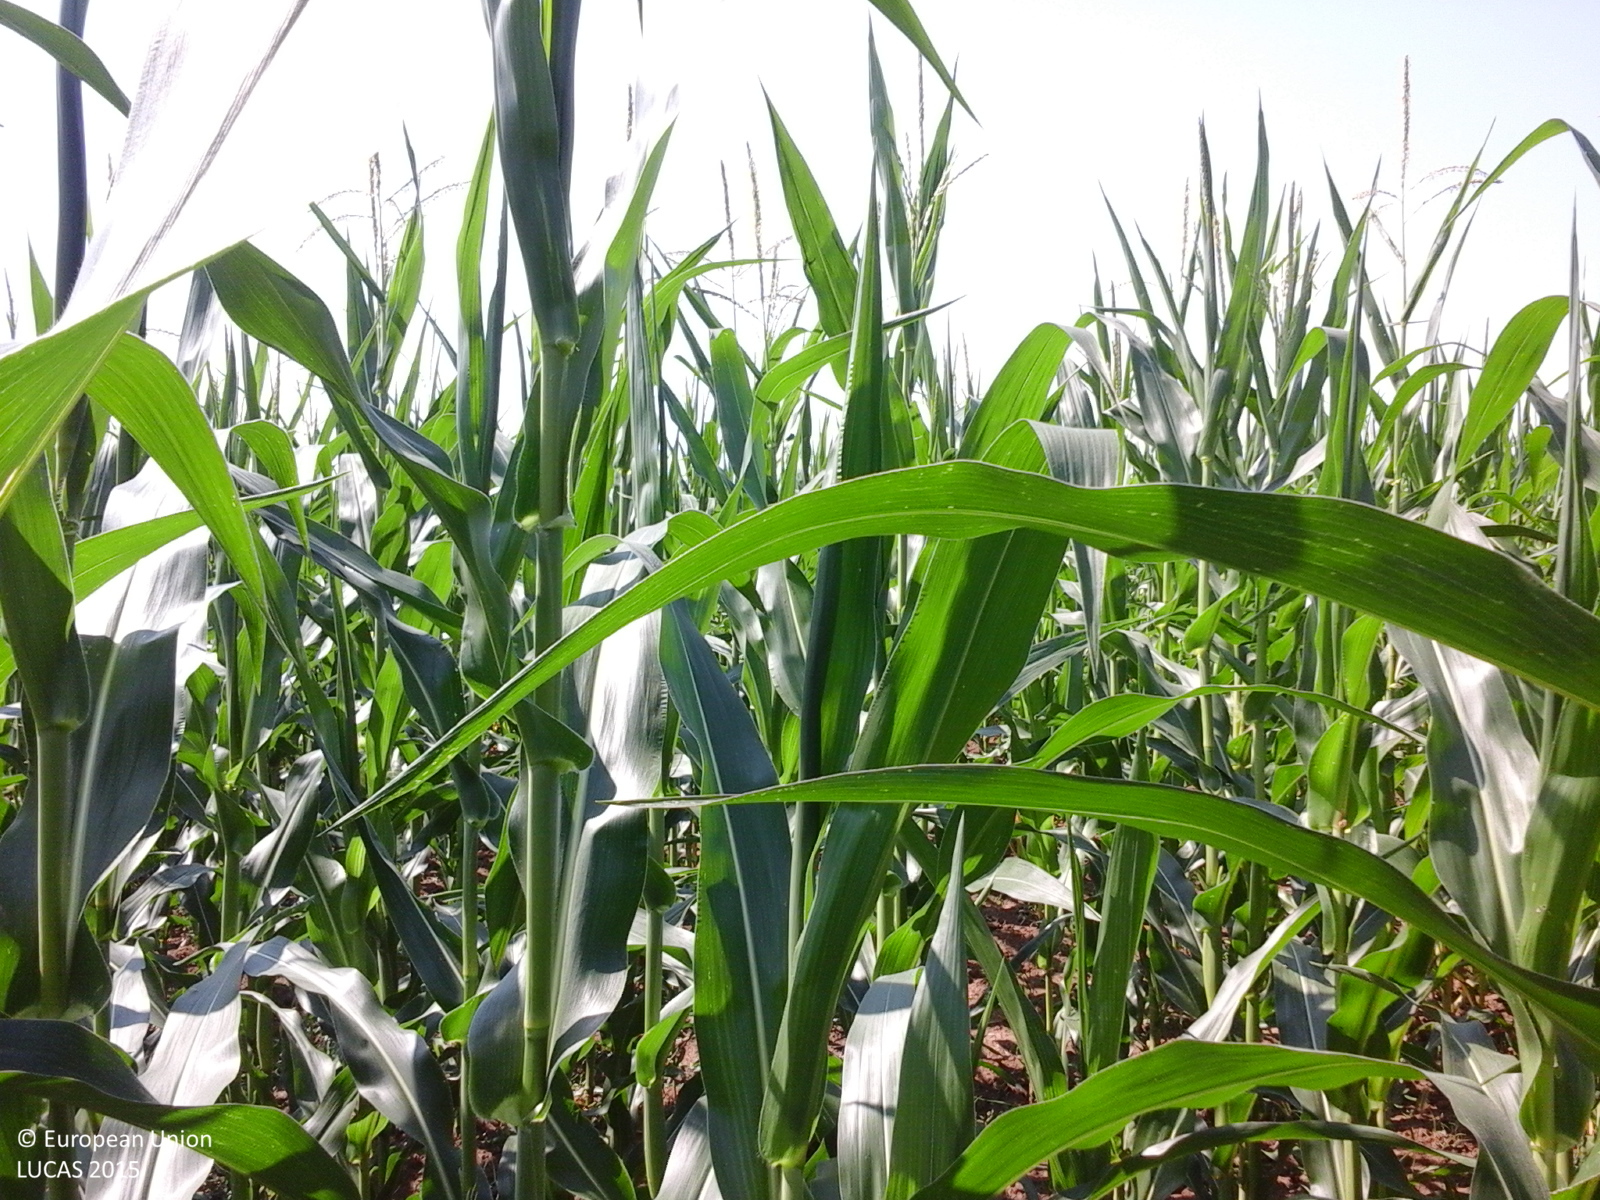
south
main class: Cropland
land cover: Maize
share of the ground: > 75 %
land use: Agriculture (excluding fallow land and kitchen gardens)
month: July
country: RO
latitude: 44.7805
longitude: 25.4481
